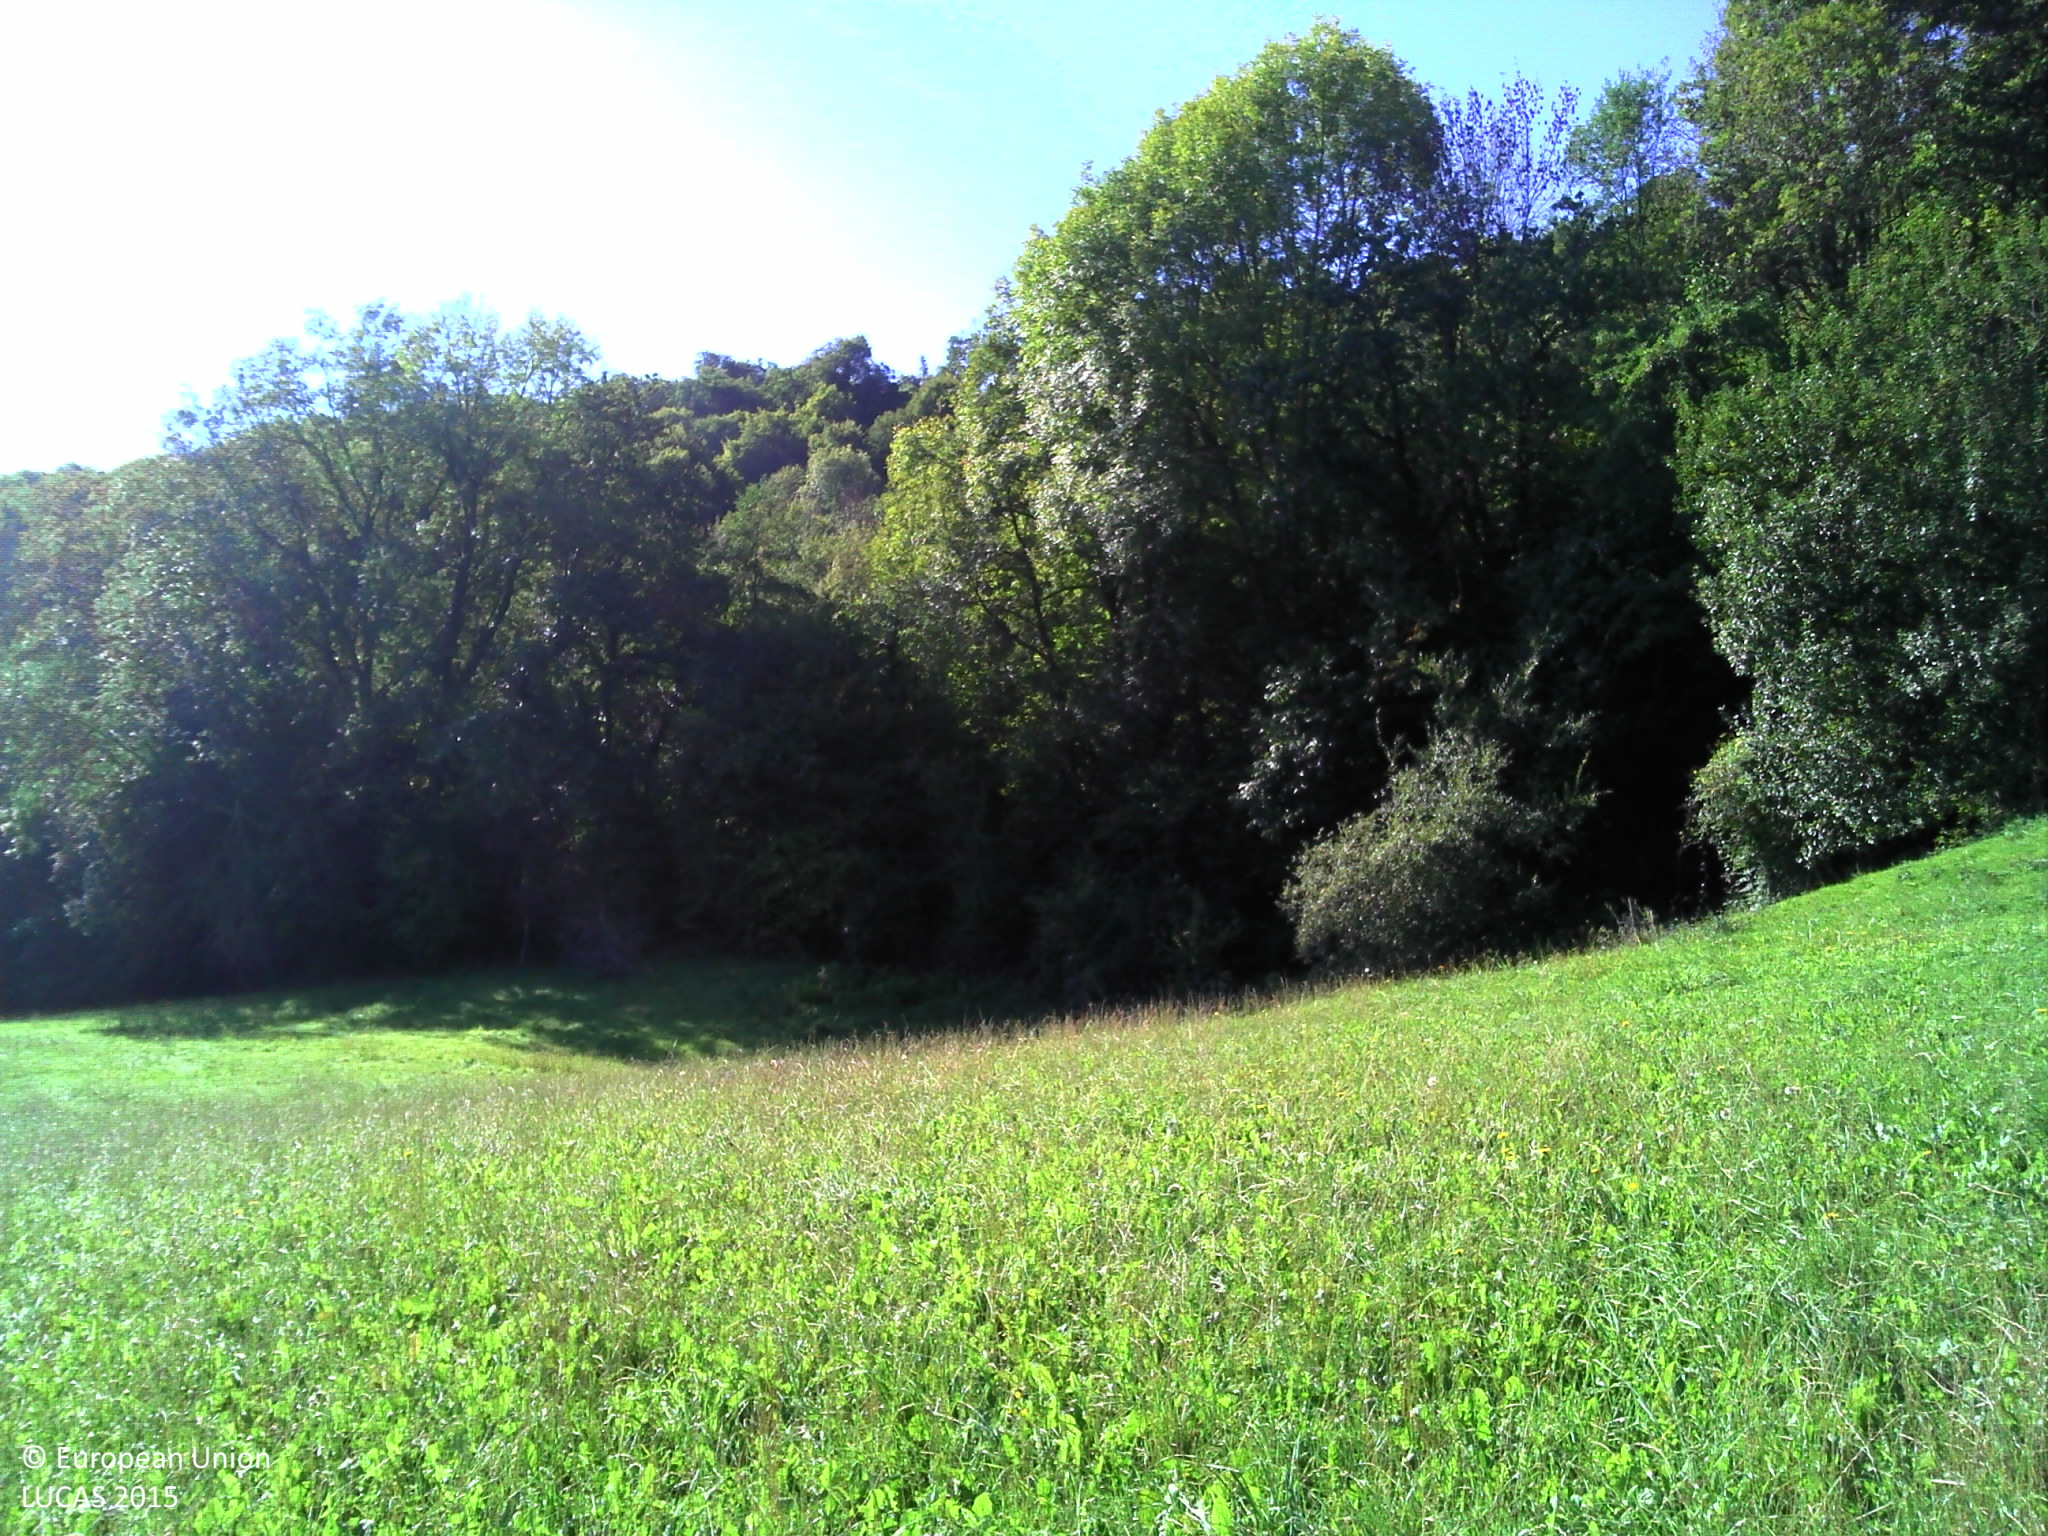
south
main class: Grassland
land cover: Grassland without tree/shrub cover
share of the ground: > 75 %
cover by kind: herbaceous plants 100 %
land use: Agriculture (excluding fallow land and kitchen gardens)
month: September
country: FR
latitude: 43.1543
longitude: -0.3974
